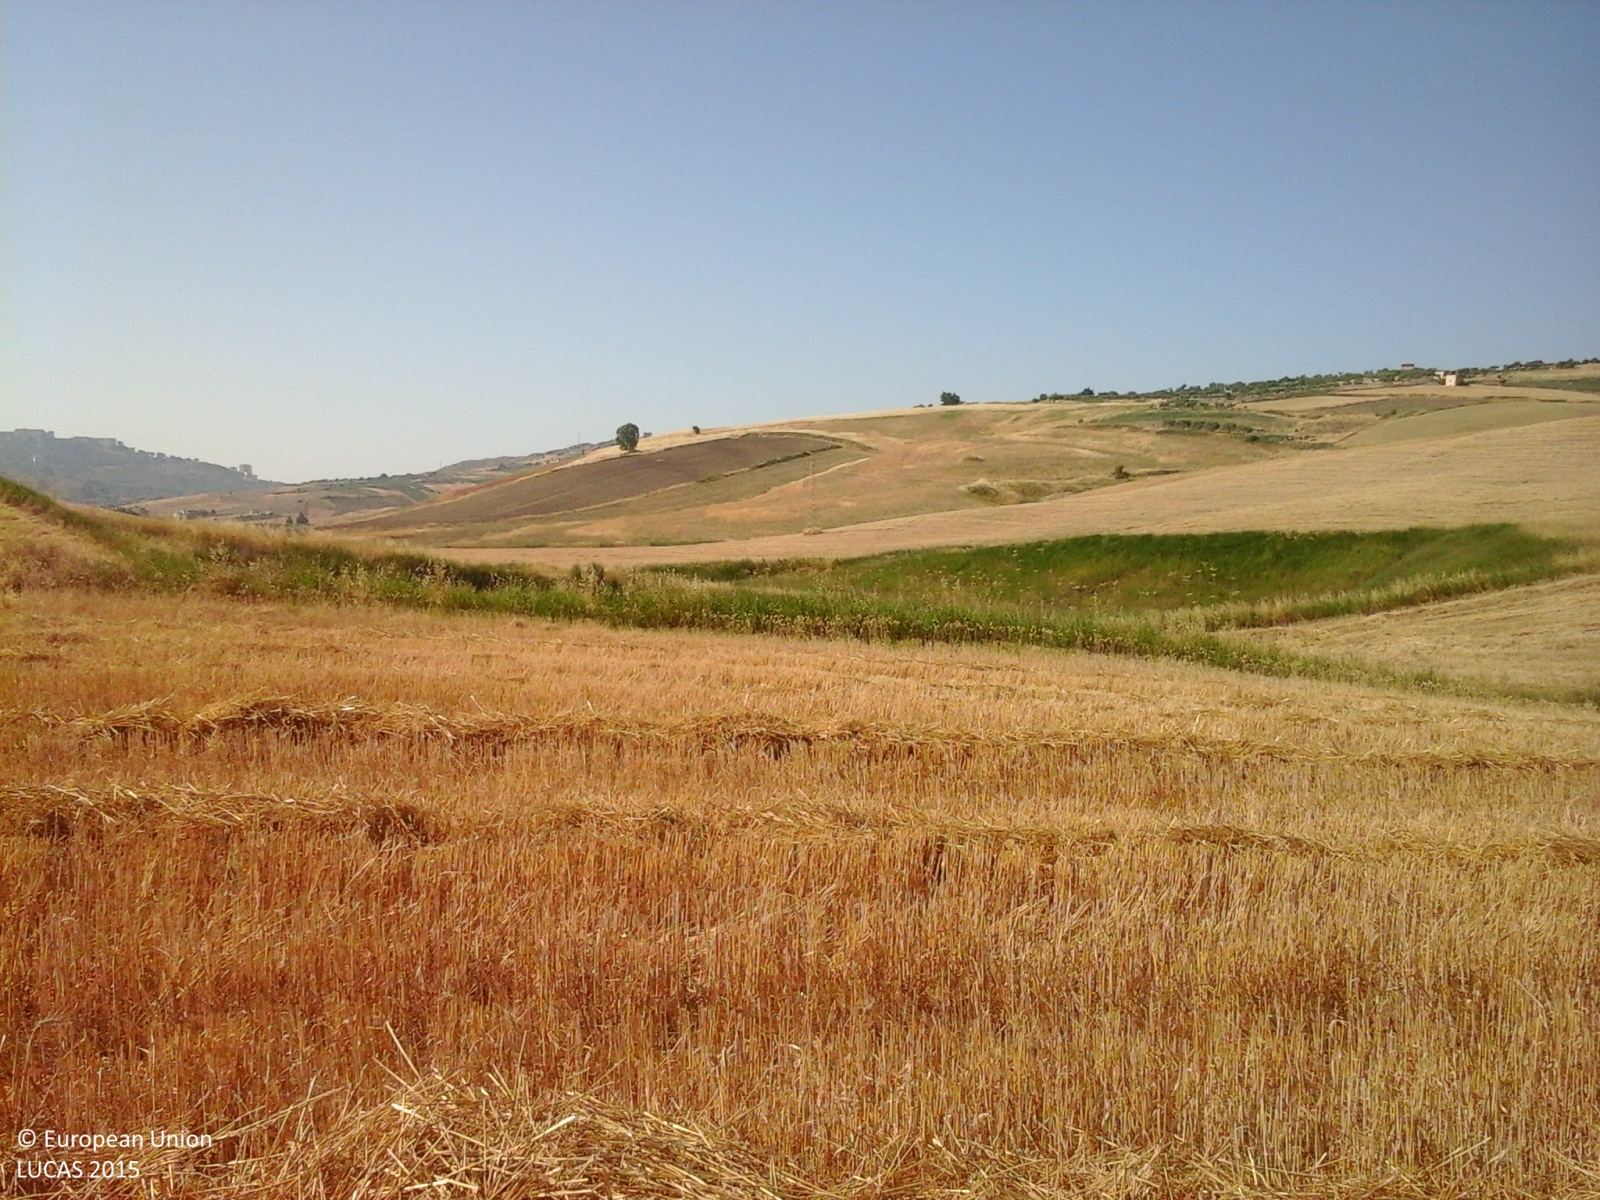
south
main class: Cropland
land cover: Durum wheat
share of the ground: > 75 %
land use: Agriculture (excluding fallow land and kitchen gardens)
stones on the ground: < 10 %
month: July
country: IT
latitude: 37.3541
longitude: 13.5512
